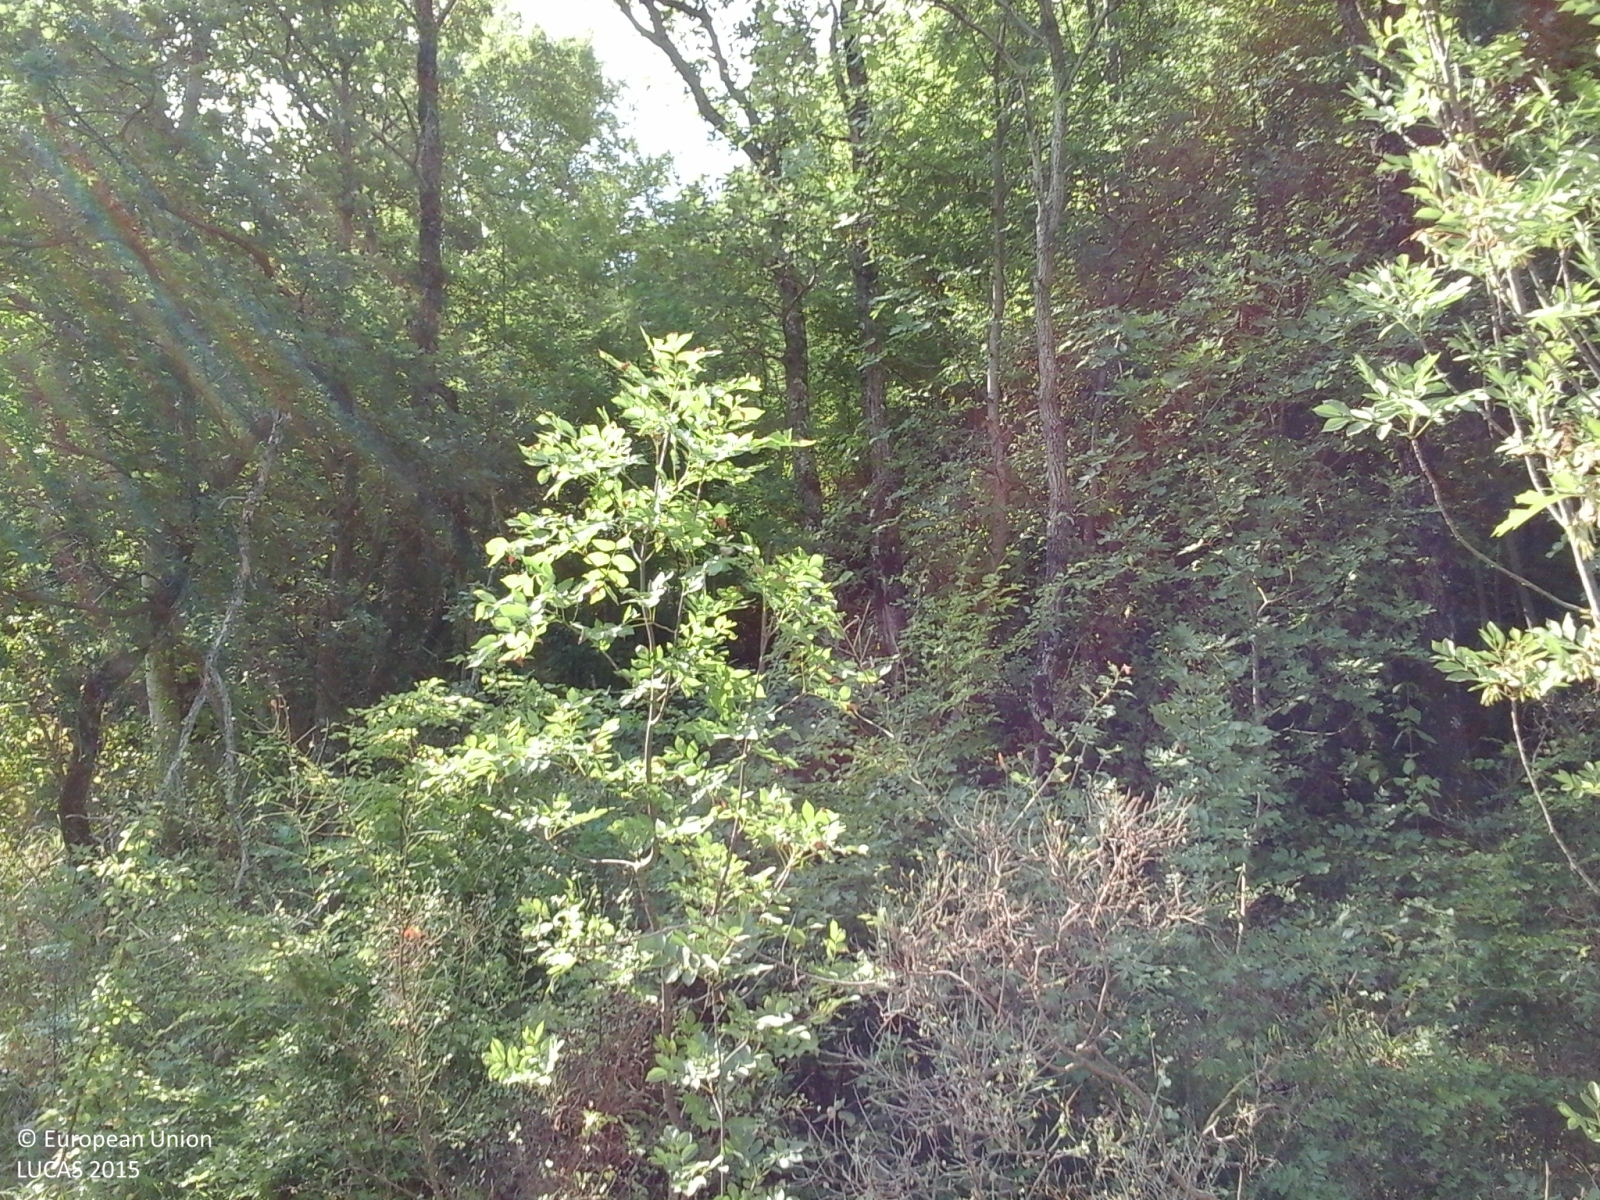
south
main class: Woodland
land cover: Broadleaved woodland
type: thermophilous deciduous forest
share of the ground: > 75 %
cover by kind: broadleaved forest trees 90 %, shrubs 5 %, herbaceous plants 5 %
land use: Semi-natural and natural areas not in use
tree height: > 5 m
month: August
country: IT
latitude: 41.5140
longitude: 14.2860
